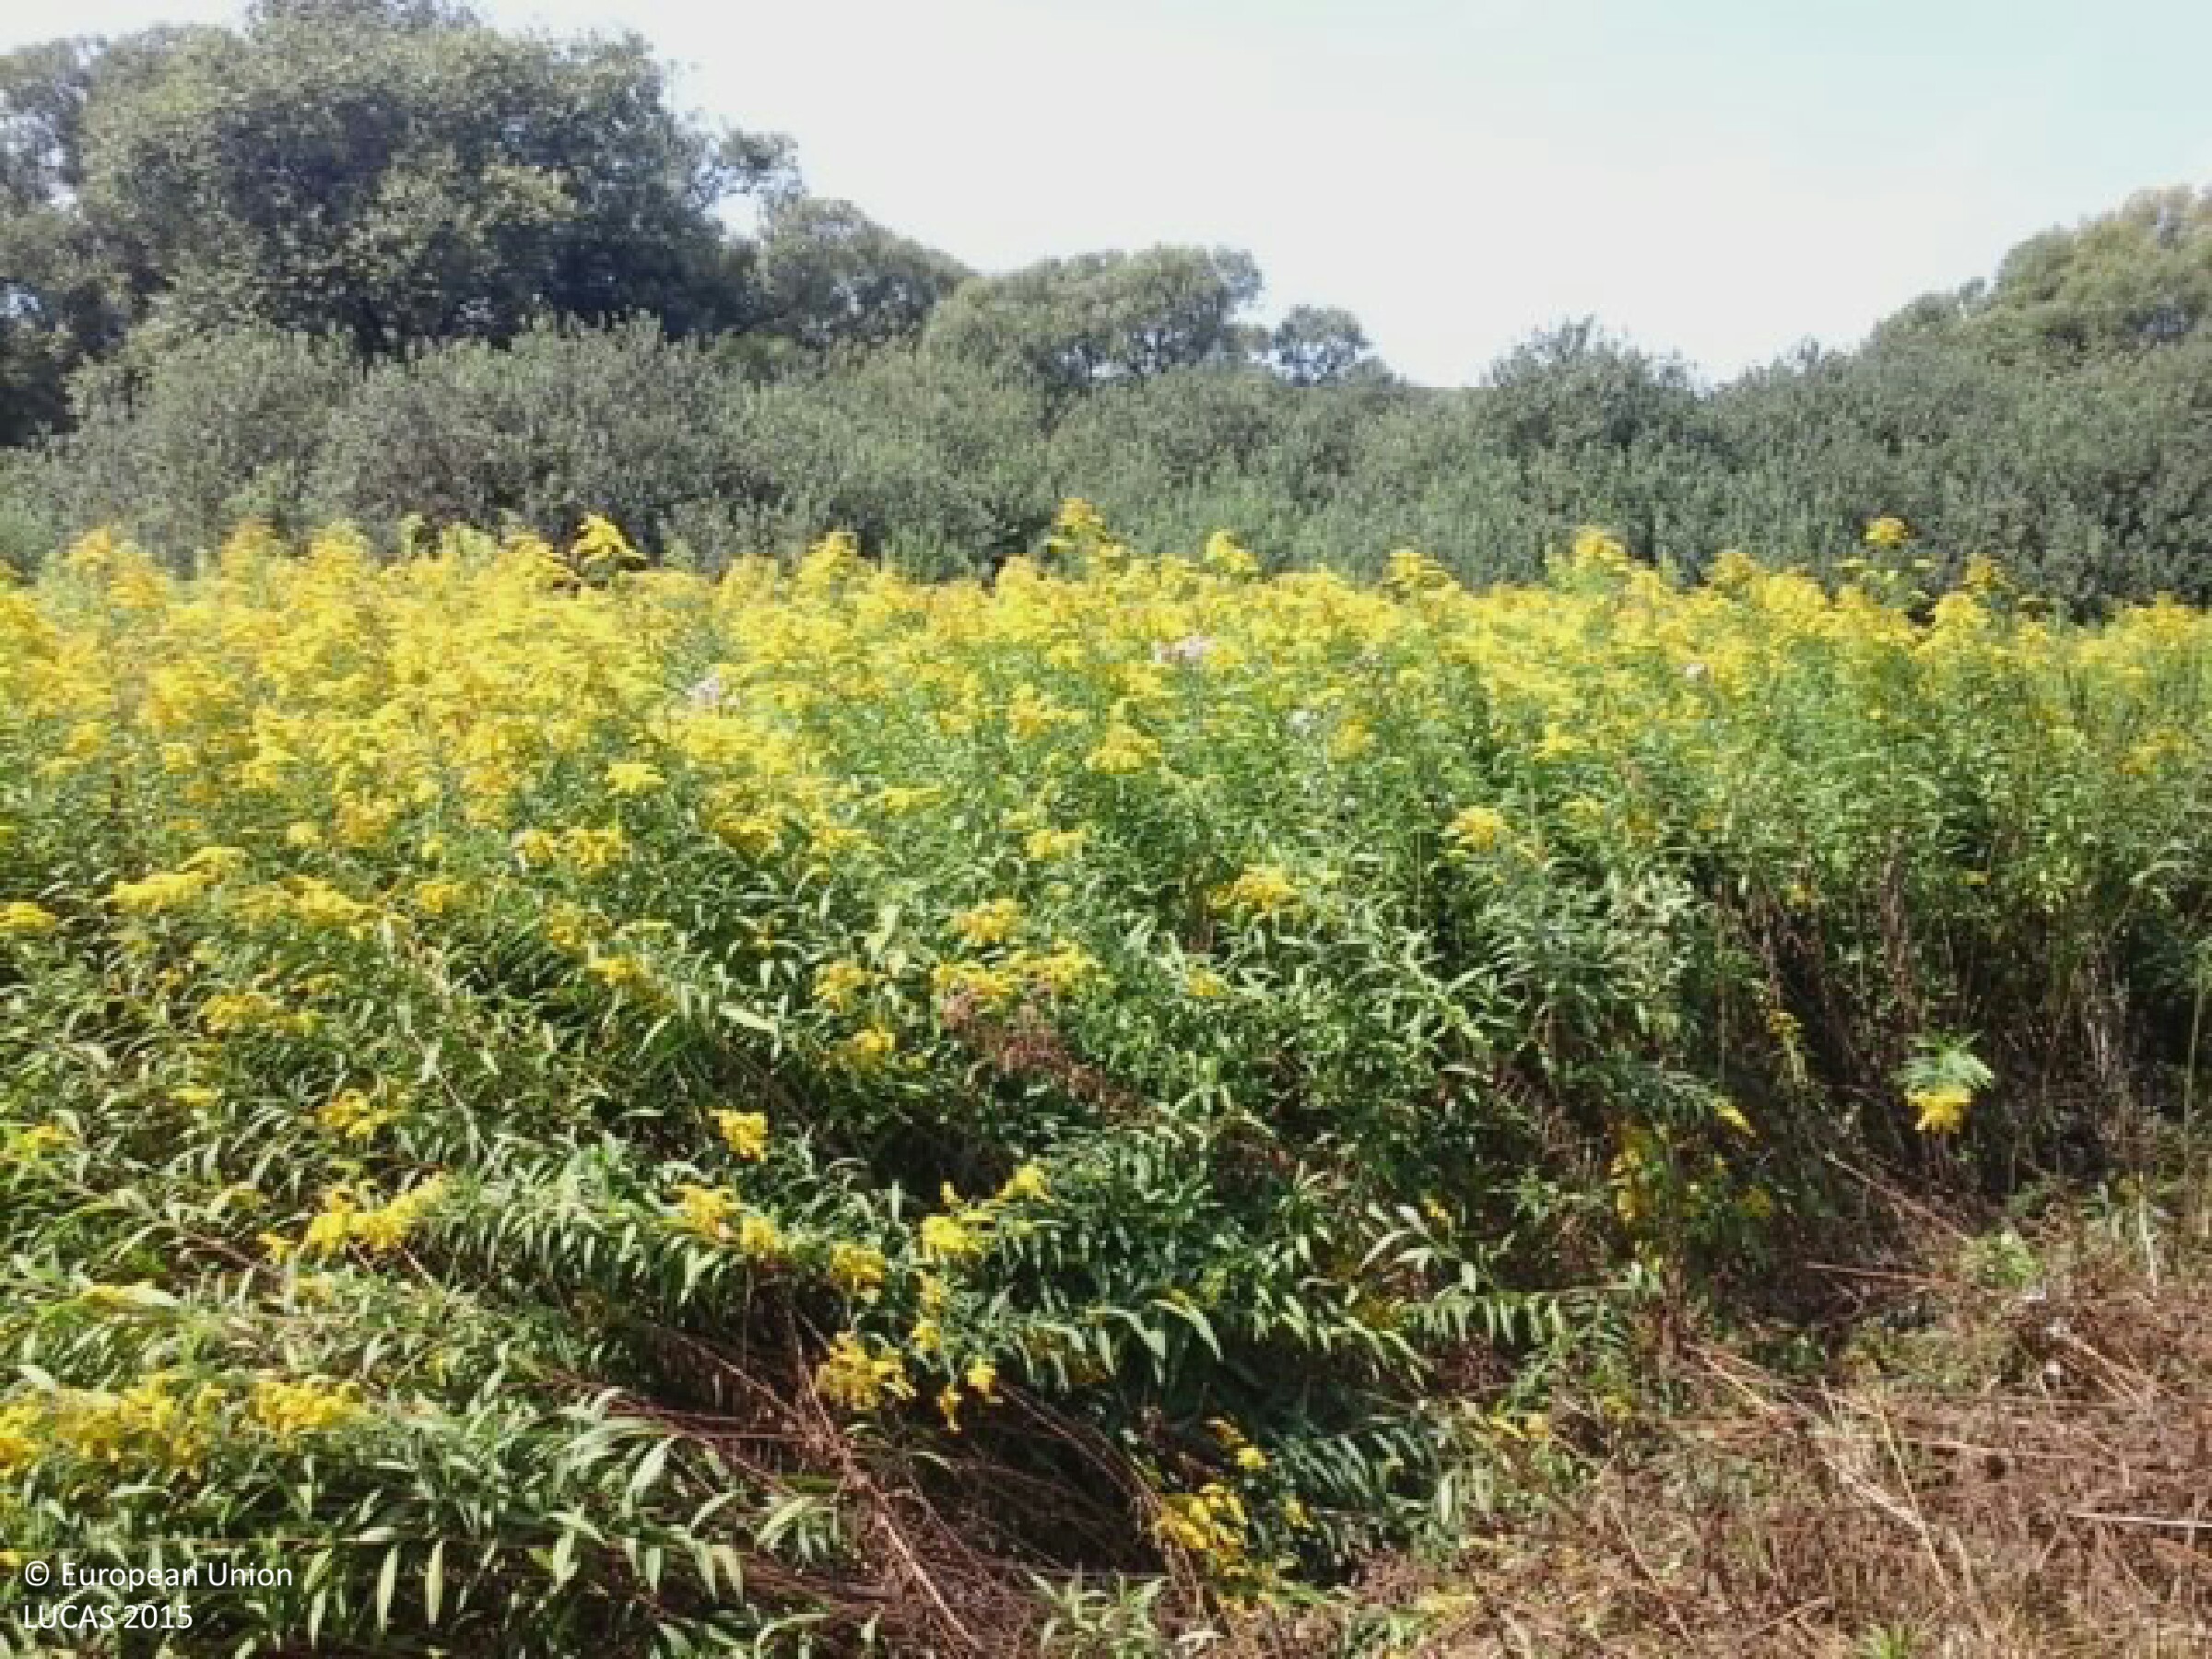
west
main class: Grassland
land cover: Spontaneously vegetated surfaces
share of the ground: > 75 %
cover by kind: herbaceous plants 95 %, shrubs 5 %
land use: Semi-natural and natural areas not in use
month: August
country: HU
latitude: 46.4066
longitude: 17.0662
